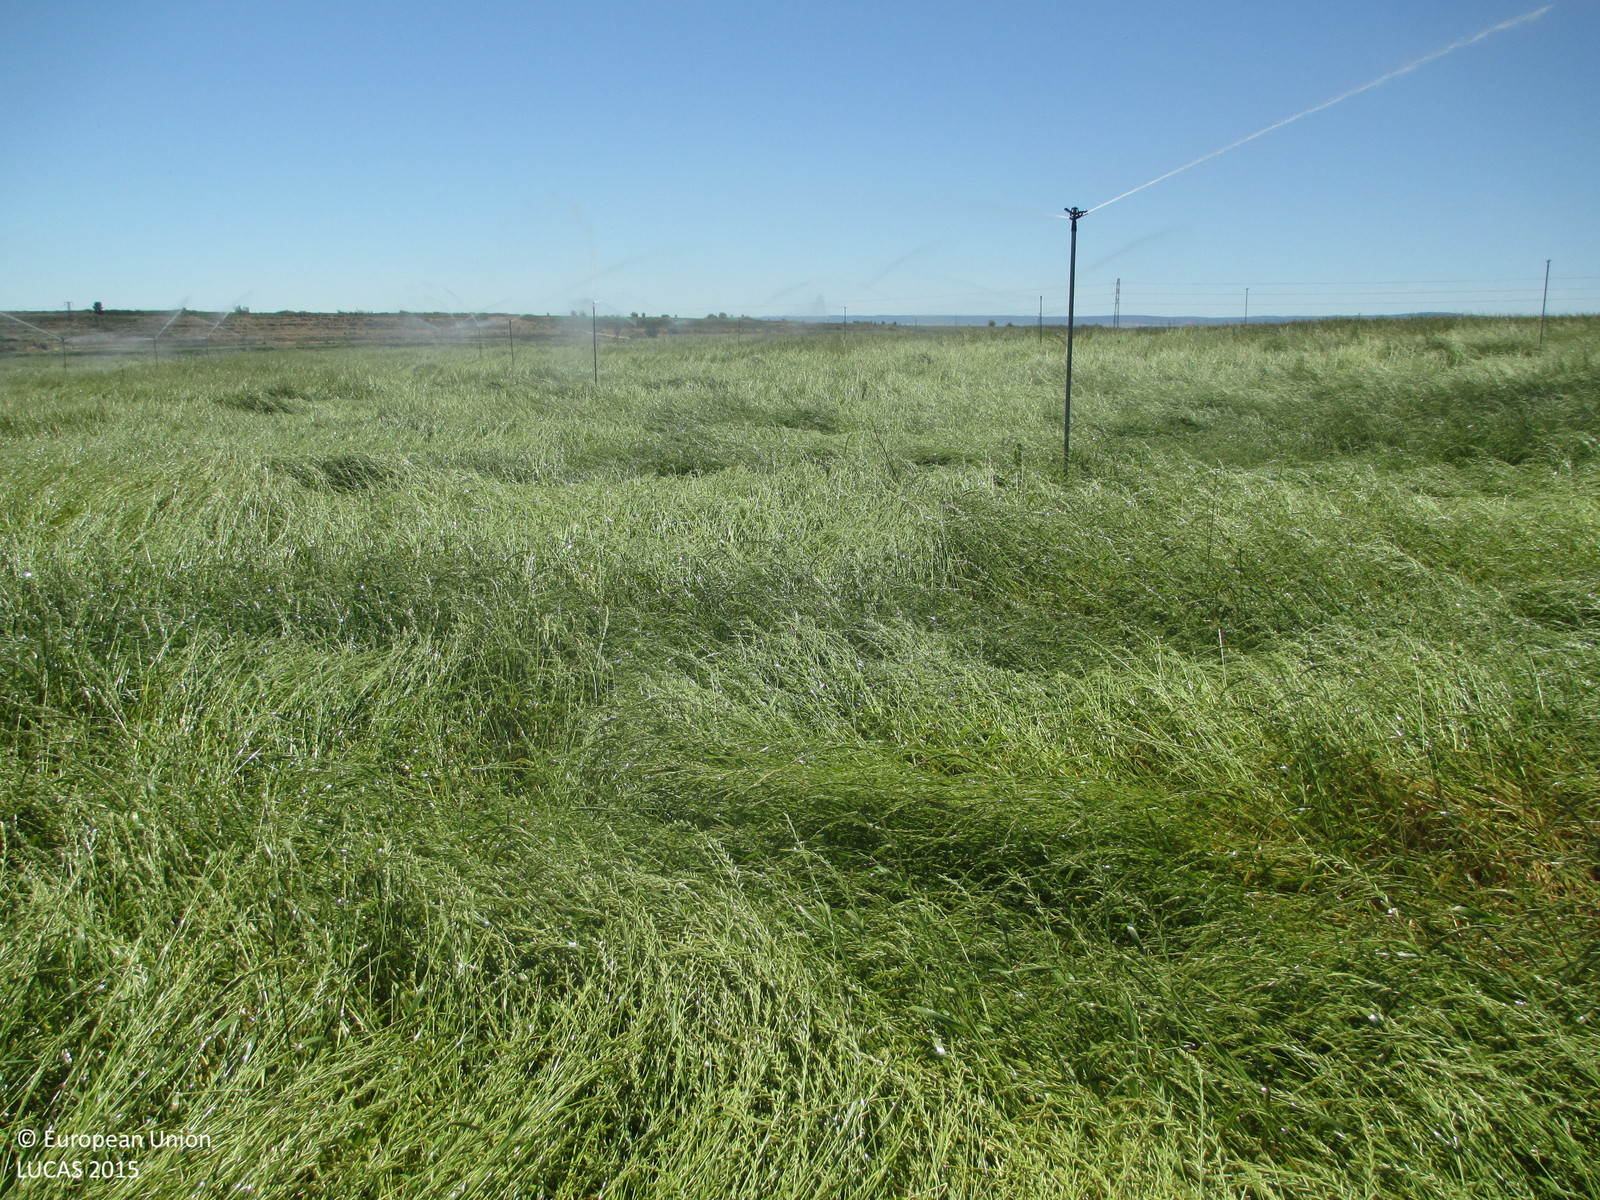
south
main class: Cropland
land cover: Temporary grasslands
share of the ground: > 75 %
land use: Agriculture (excluding fallow land and kitchen gardens)
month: May
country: ES
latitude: 41.8780
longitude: -0.2496
